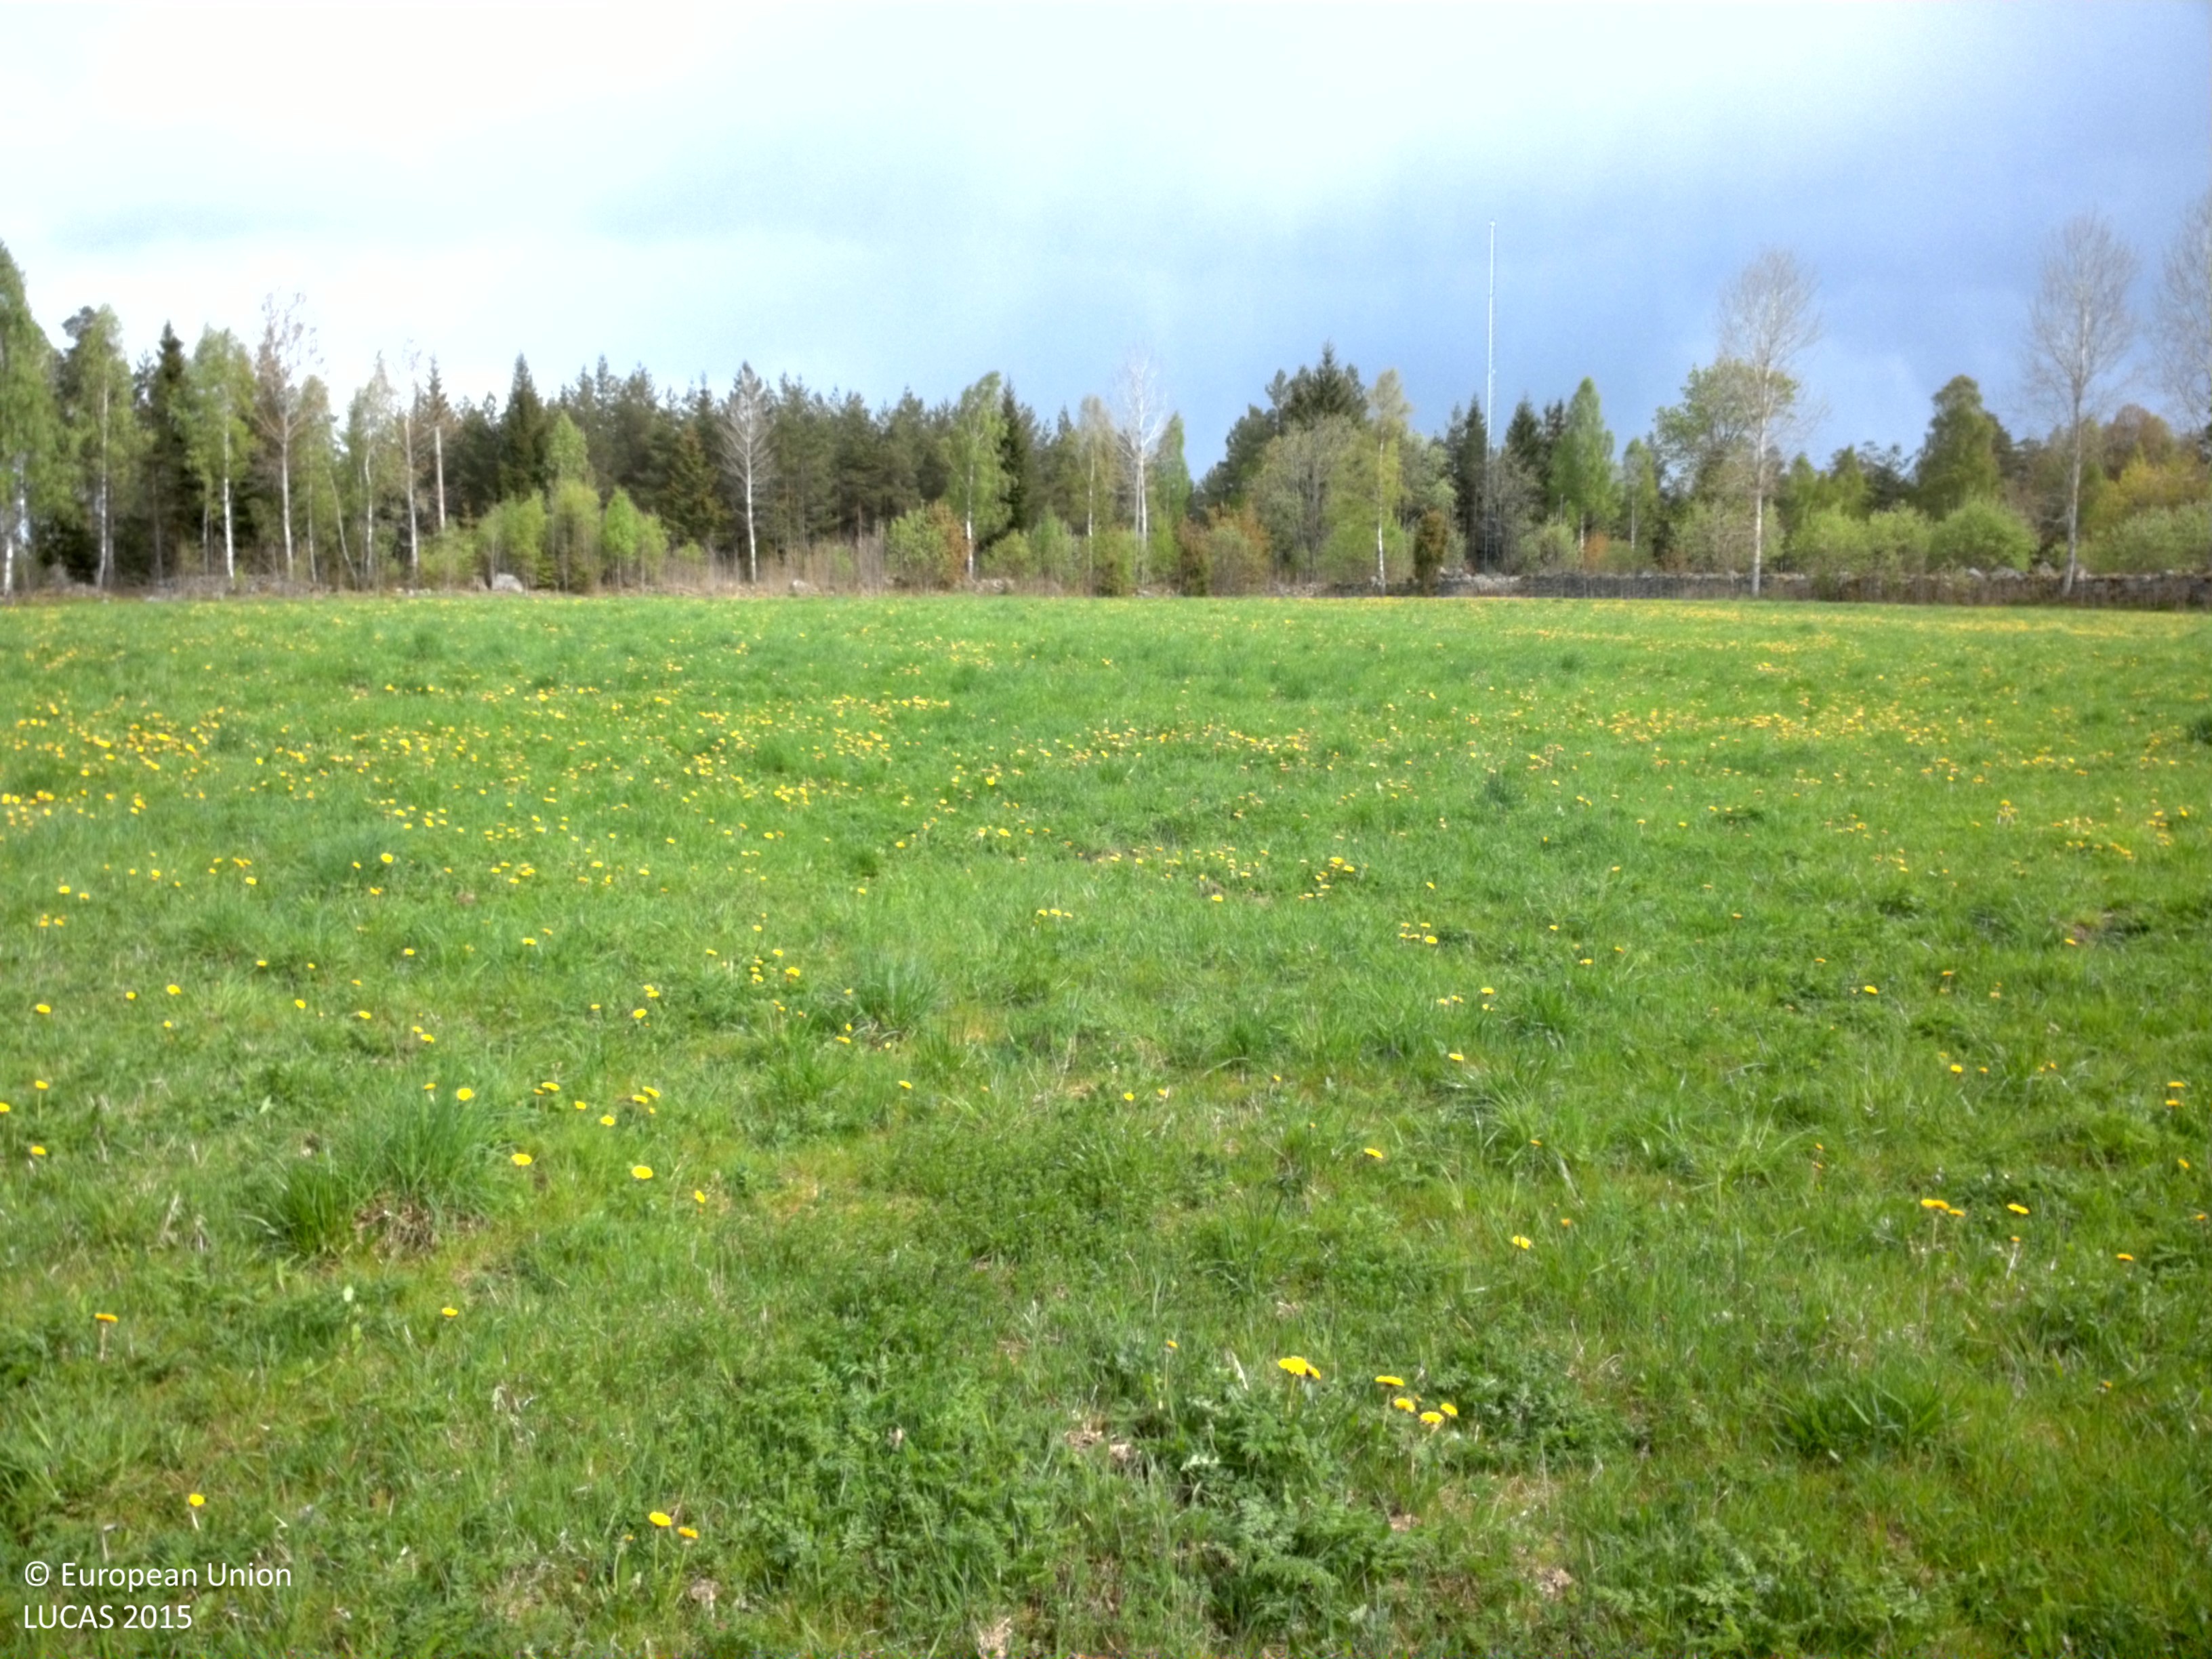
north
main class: Grassland
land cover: Grassland without tree/shrub cover
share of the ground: > 75 %
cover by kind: herbaceous plants 100 %
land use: Agriculture (excluding fallow land and kitchen gardens)
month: May
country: SE
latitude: 56.6908
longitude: 15.3047
